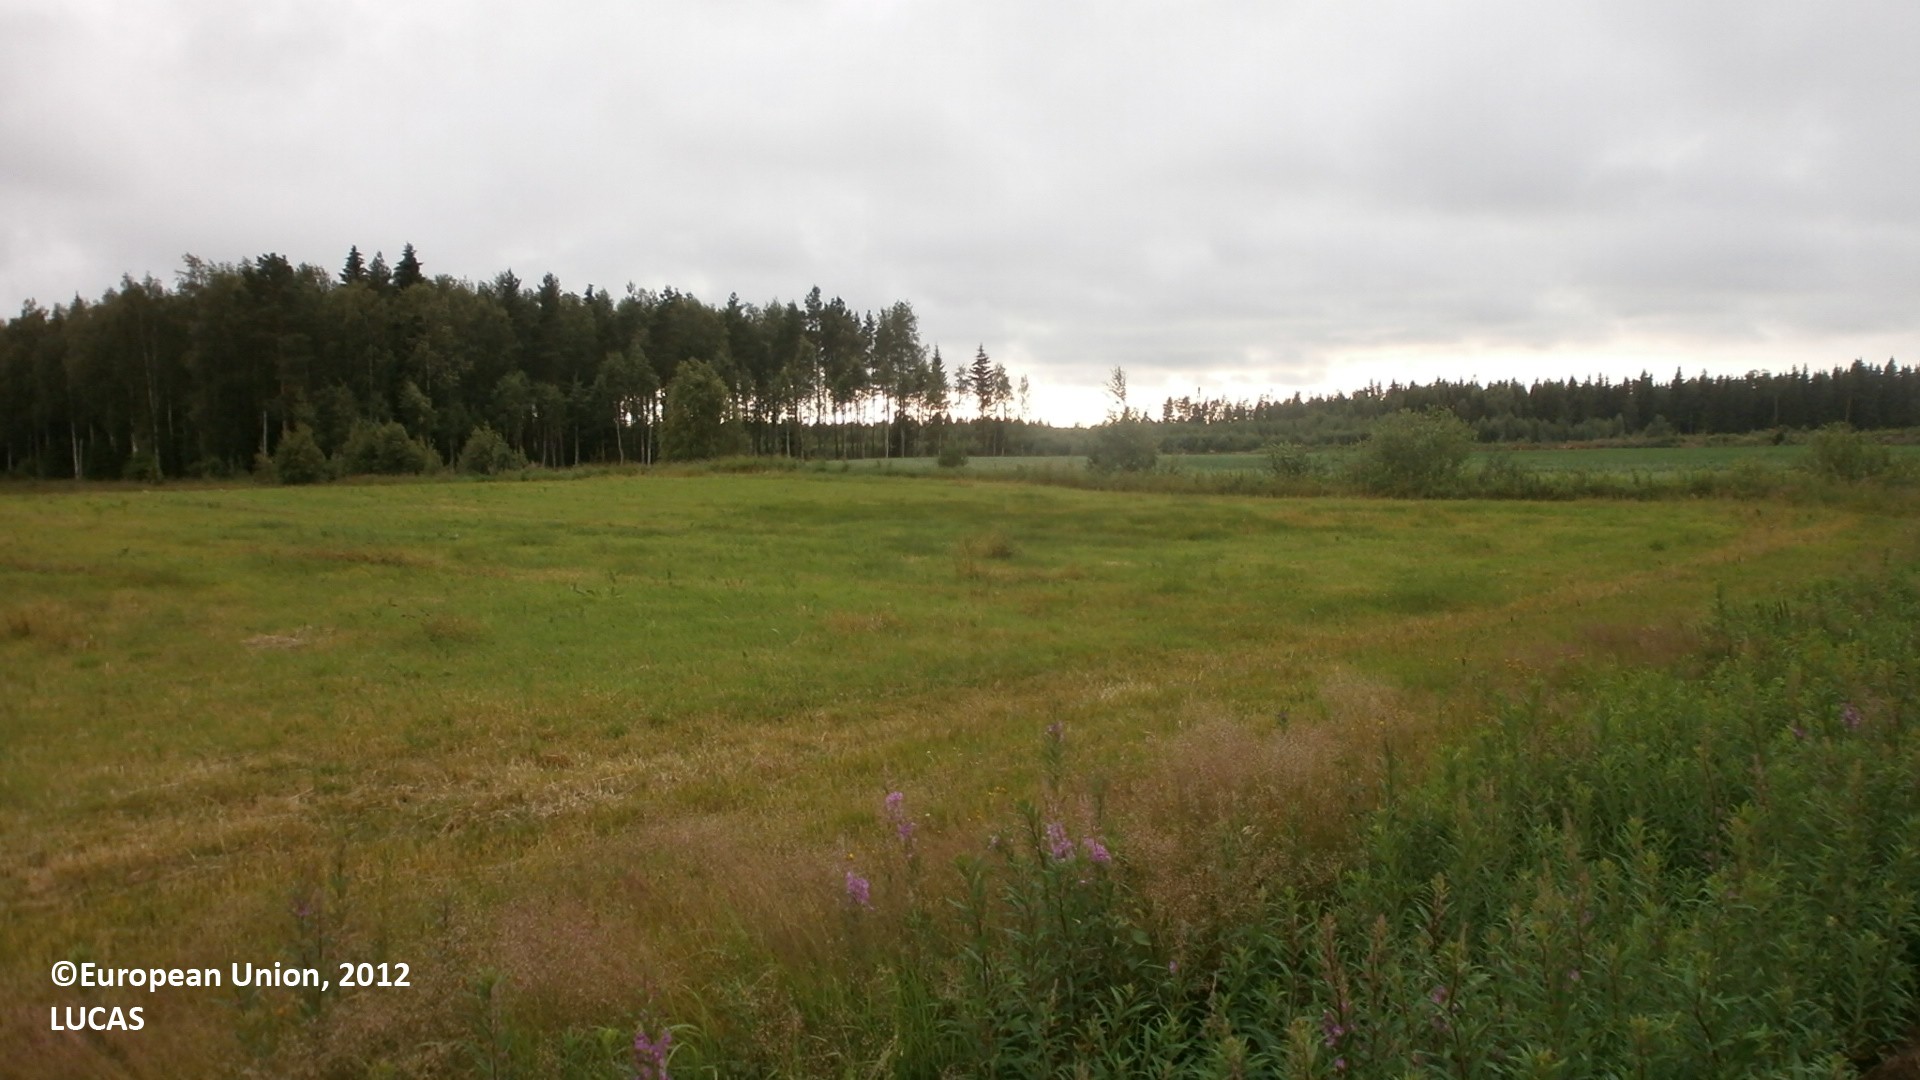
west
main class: Grassland
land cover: Grassland without tree/shrub cover
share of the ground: 10 - 25 %
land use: Agriculture (excluding fallow land and kitchen gardens)
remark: Harvested field
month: July
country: FI
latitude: 64.2670
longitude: 24.0386
